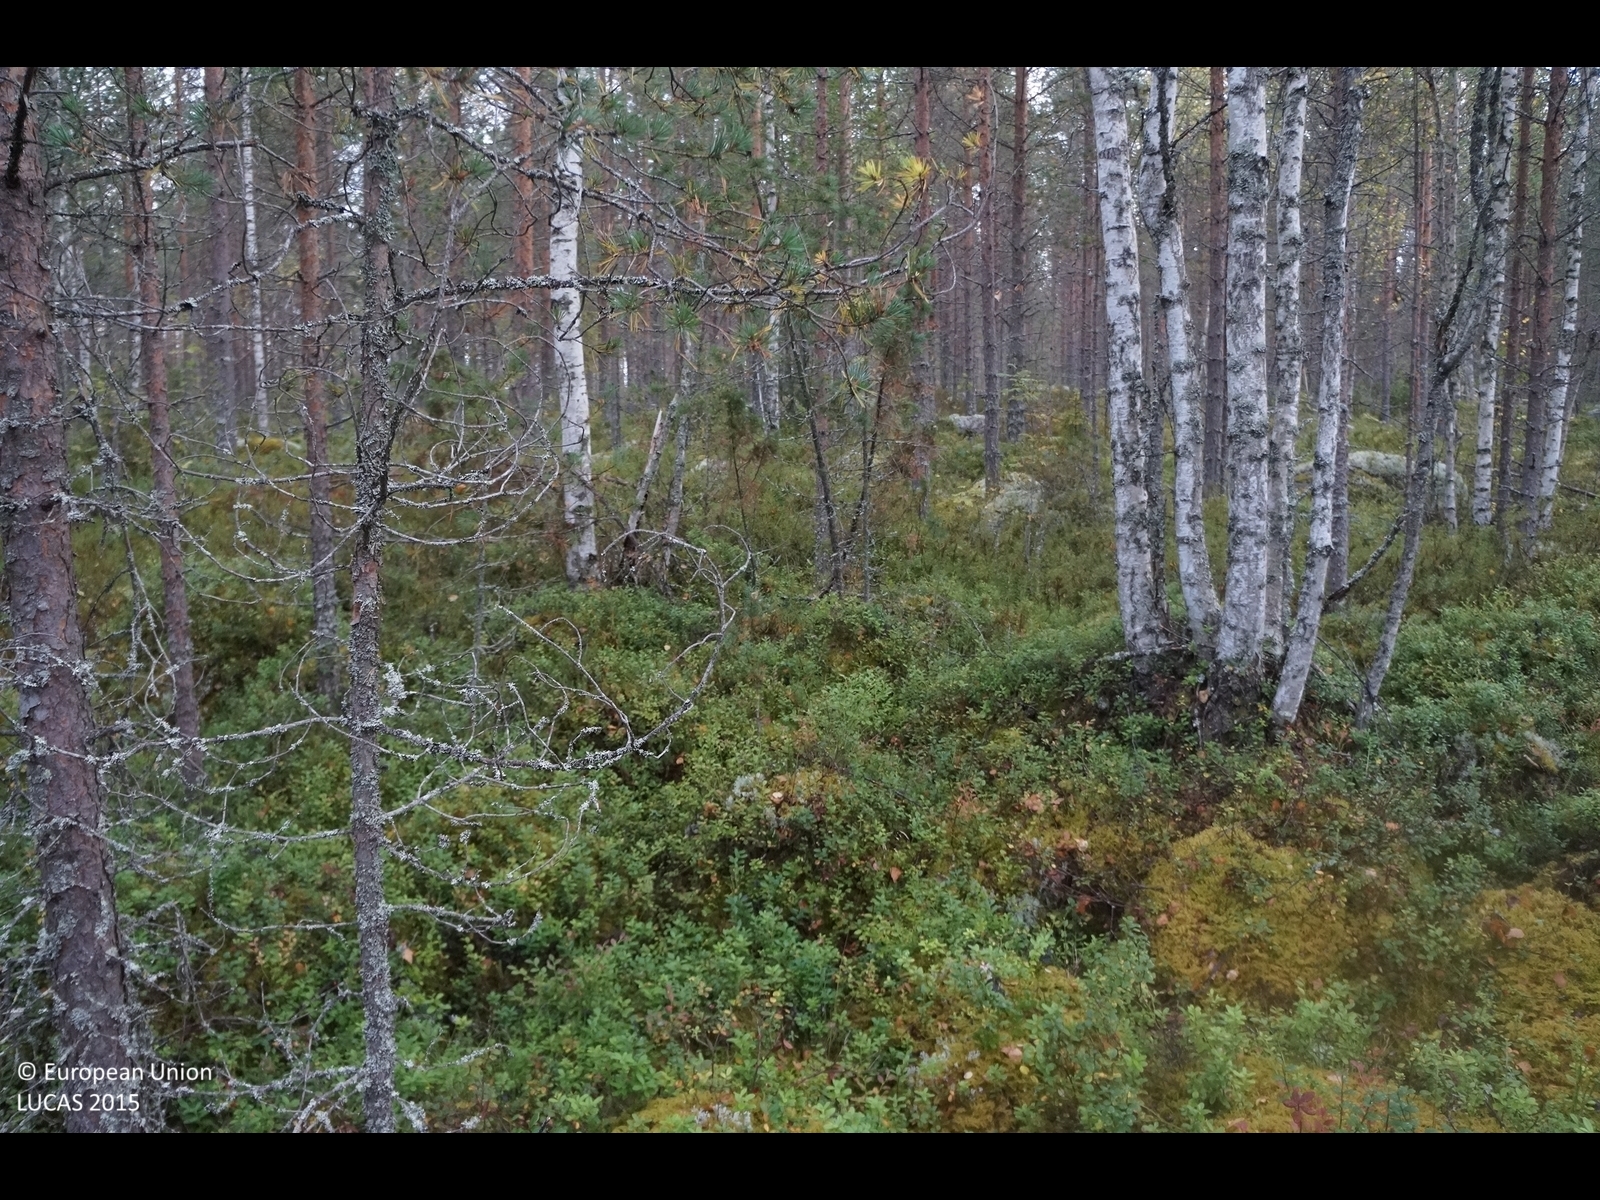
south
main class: Woodland
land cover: Pine dominated coniferous woodland
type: boreal forest
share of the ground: 50 - 75 %
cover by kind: coniferous forest trees 50 %, shrubs 20 %, lichens and mosses 15 %, consolidated bare surface 15 %
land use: Forestry
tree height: > 5 m
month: September
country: FI
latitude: 63.8991
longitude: 24.4371
